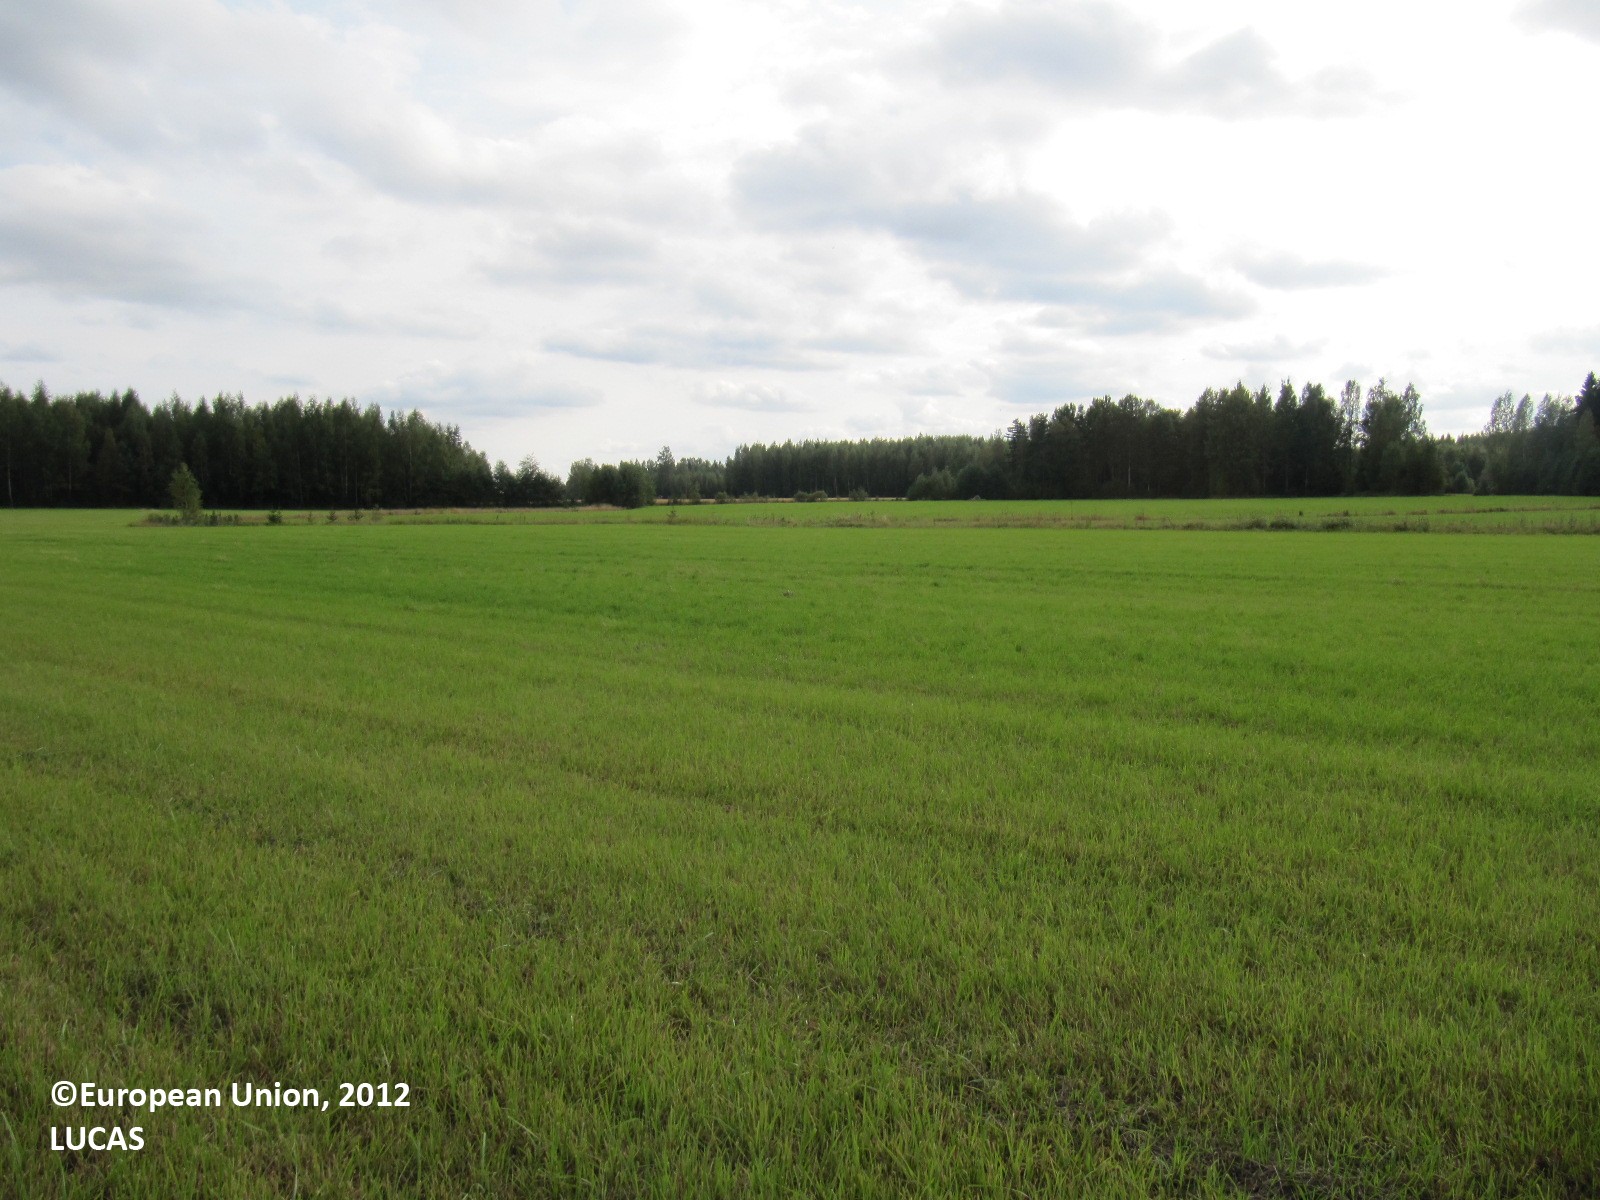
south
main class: Grassland
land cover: Spontaneously vegetated surfaces
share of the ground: > 75 %
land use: Agriculture (excluding fallow land and kitchen gardens)
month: August
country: FI
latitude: 61.0826
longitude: 22.9203
